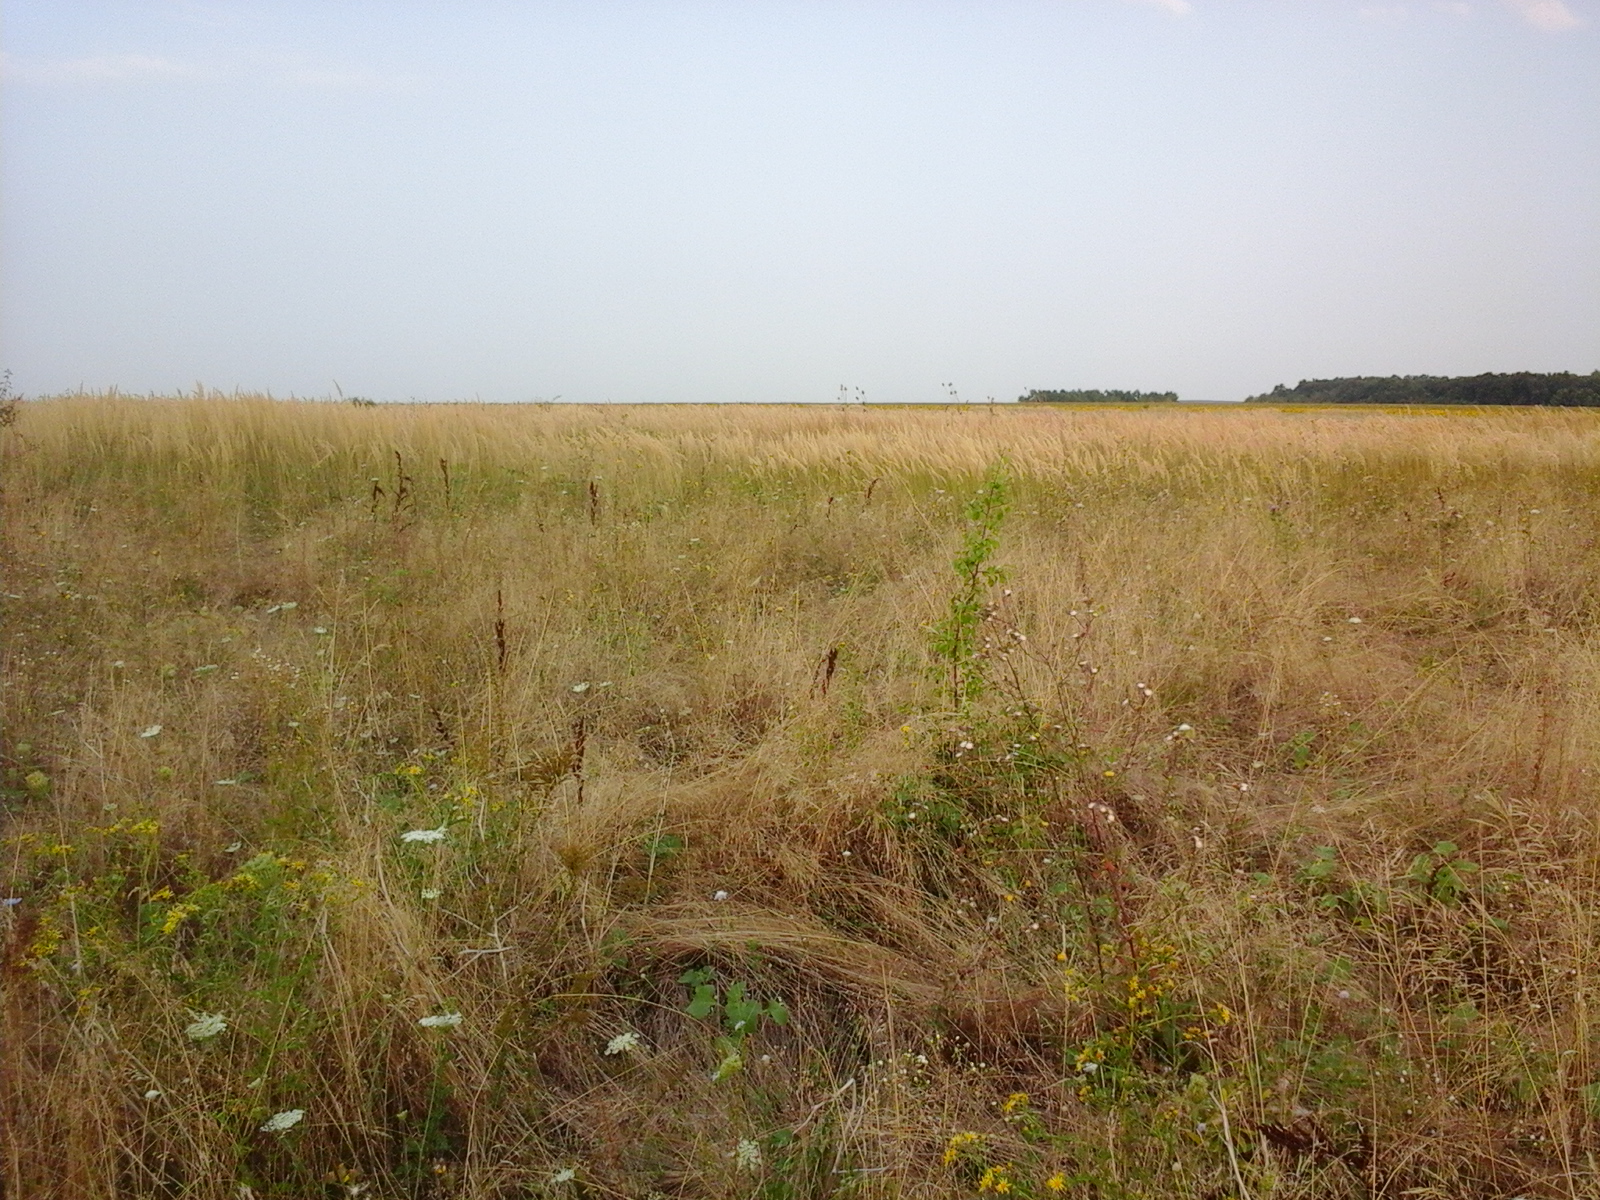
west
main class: Grassland
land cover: Spontaneously vegetated surfaces
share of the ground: > 75 %
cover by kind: herbaceous plants 100 %
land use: Fallow land
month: August
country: RO
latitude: 44.4766
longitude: 23.8504
